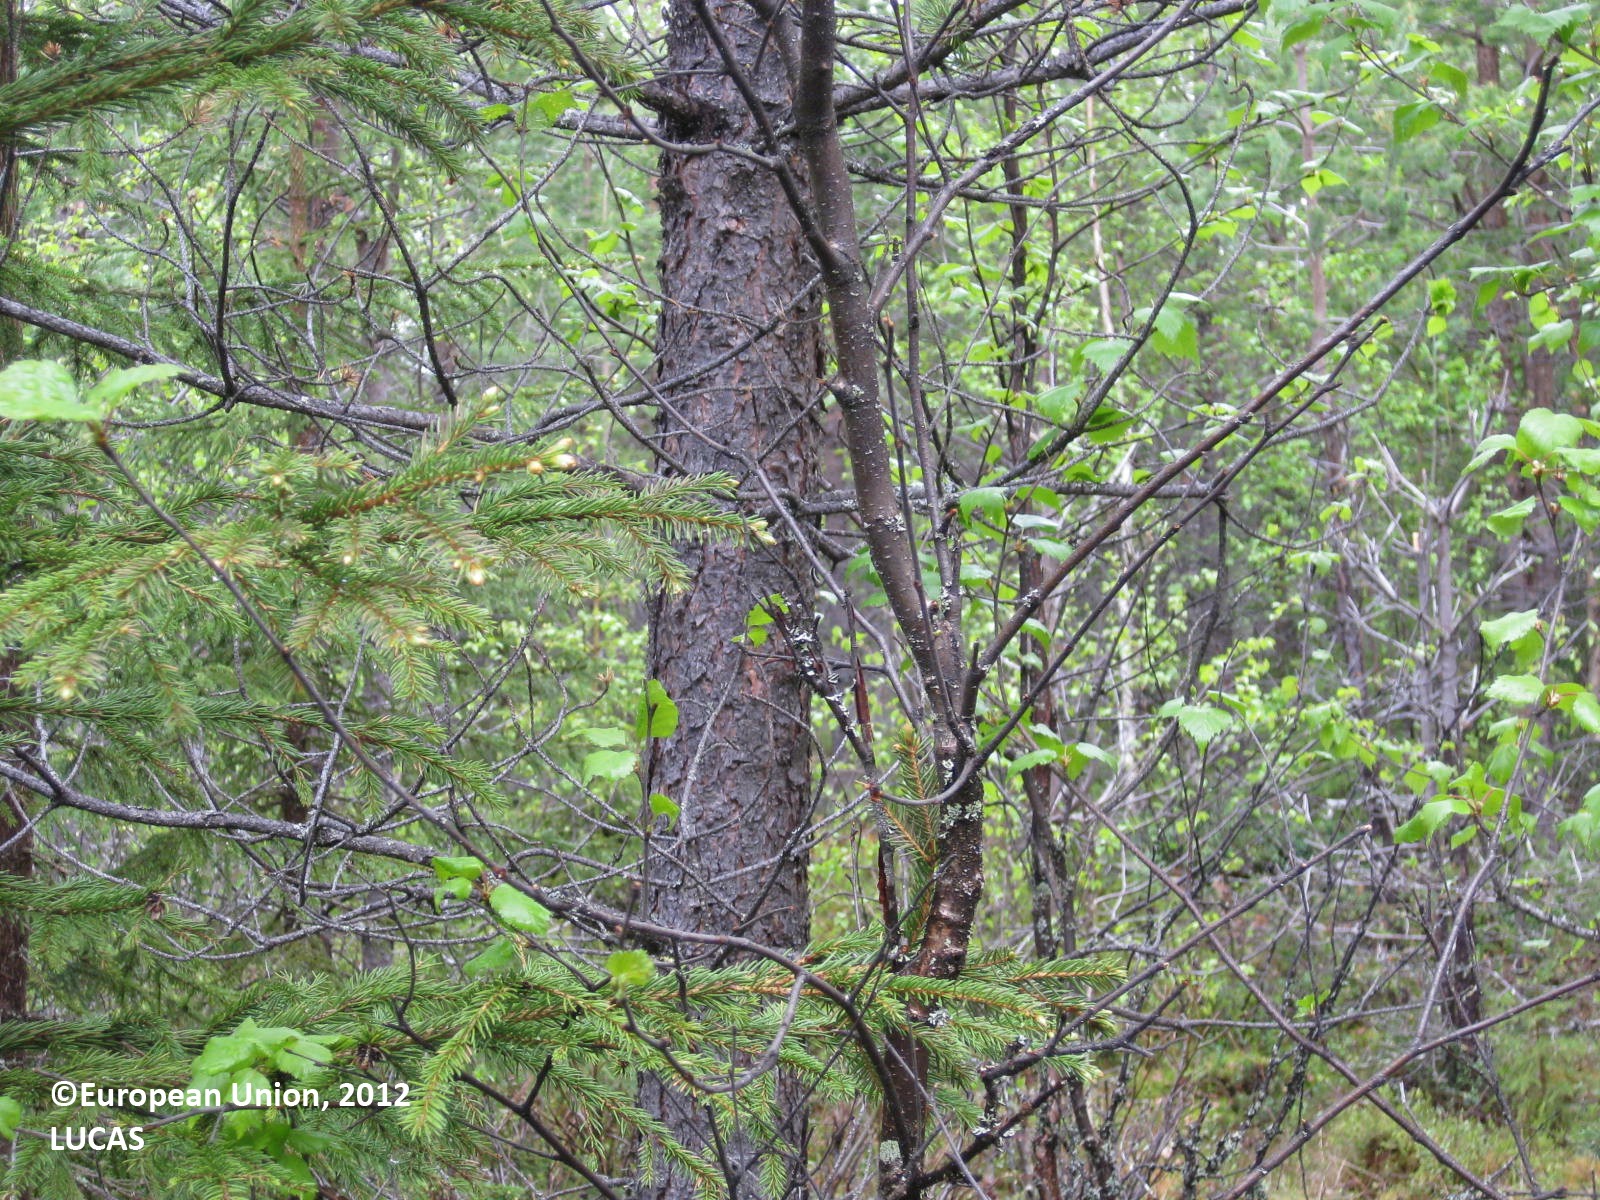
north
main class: Woodland
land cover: Pine dominated mixed woodland
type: boreal forest
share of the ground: 50 - 75 %
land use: Forestry
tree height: > 5 m
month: June
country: FI
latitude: 65.1006
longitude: 29.6450
